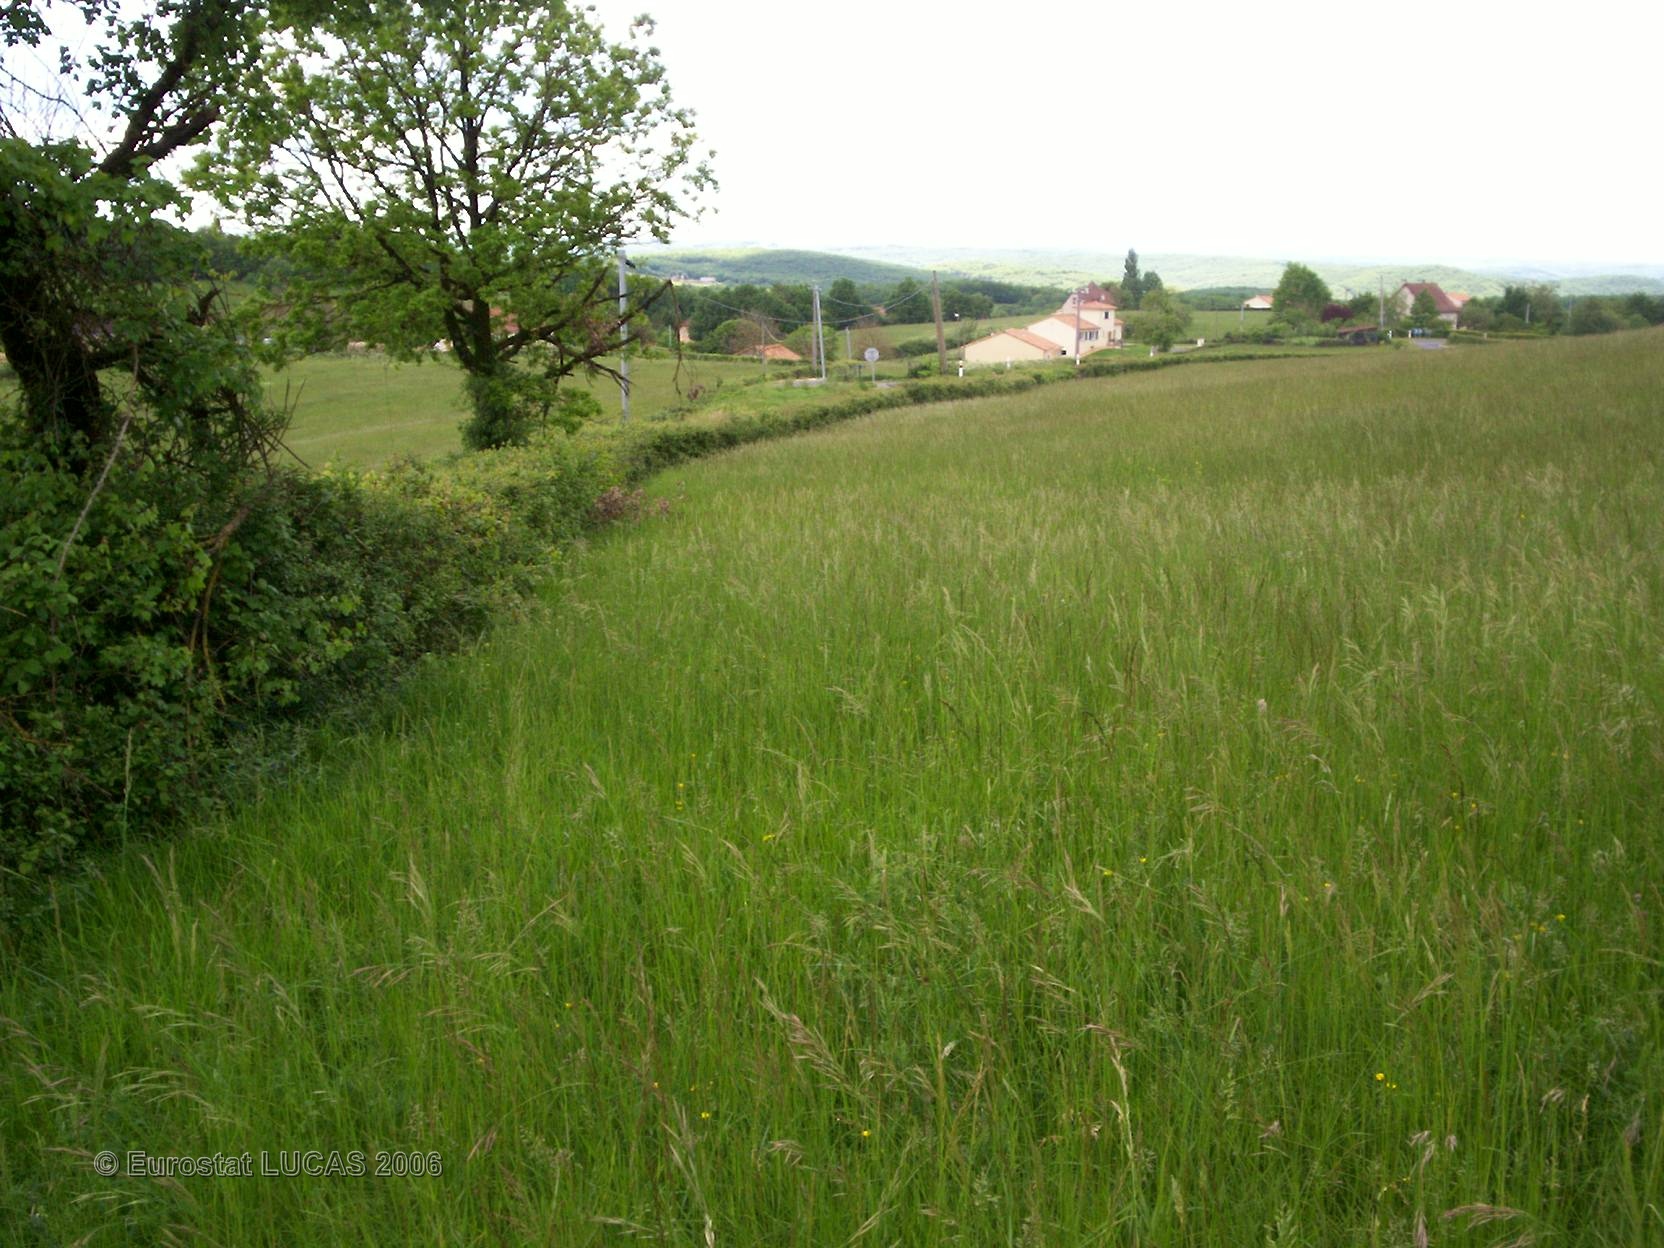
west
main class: Grassland
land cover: Grassland without tree/shrub cover
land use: Agriculture (excluding fallow land and kitchen gardens)
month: May
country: FR
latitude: 45.1096
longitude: 1.3133
